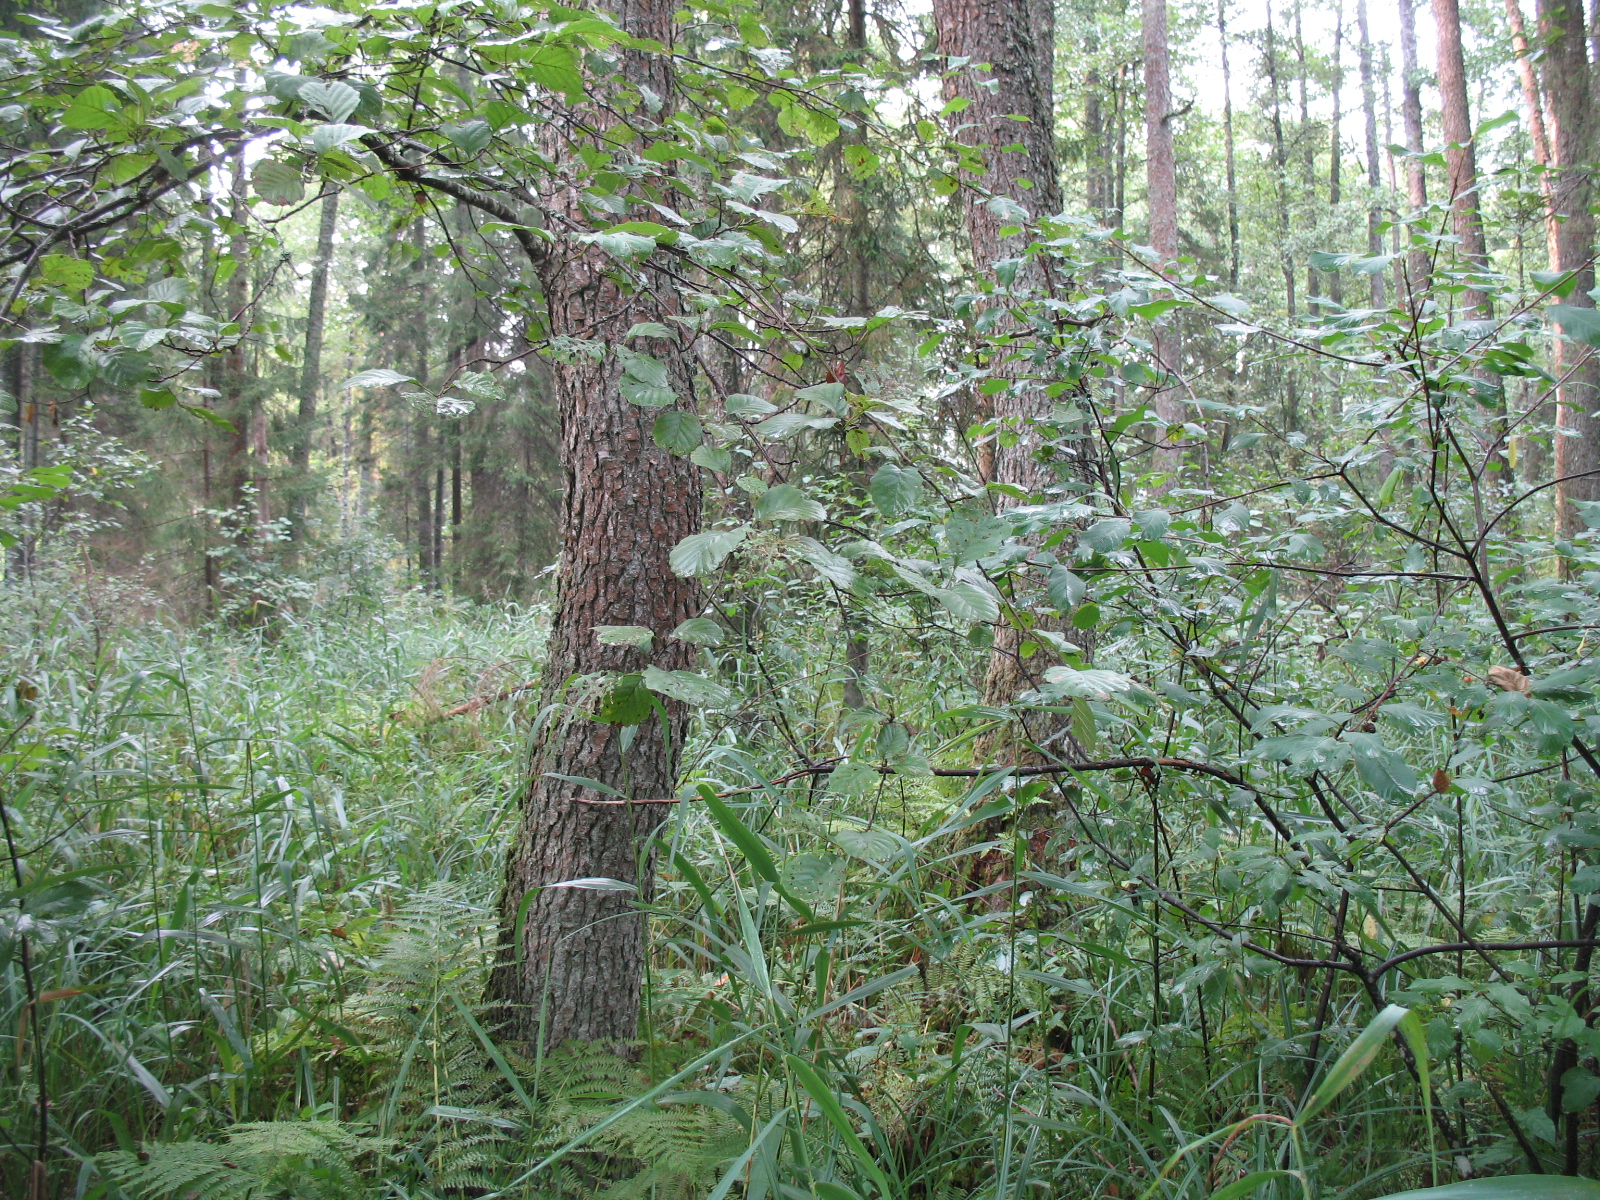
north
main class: Woodland
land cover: Broadleaved woodland
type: mire and swamp forests
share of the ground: > 75 %
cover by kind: broadleaved forest trees 75 %, herbaceous plants 15 %, coniferous forest trees 10 %
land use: Forestry
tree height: > 5 m
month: September
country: LV
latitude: 56.1601
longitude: 26.1937
